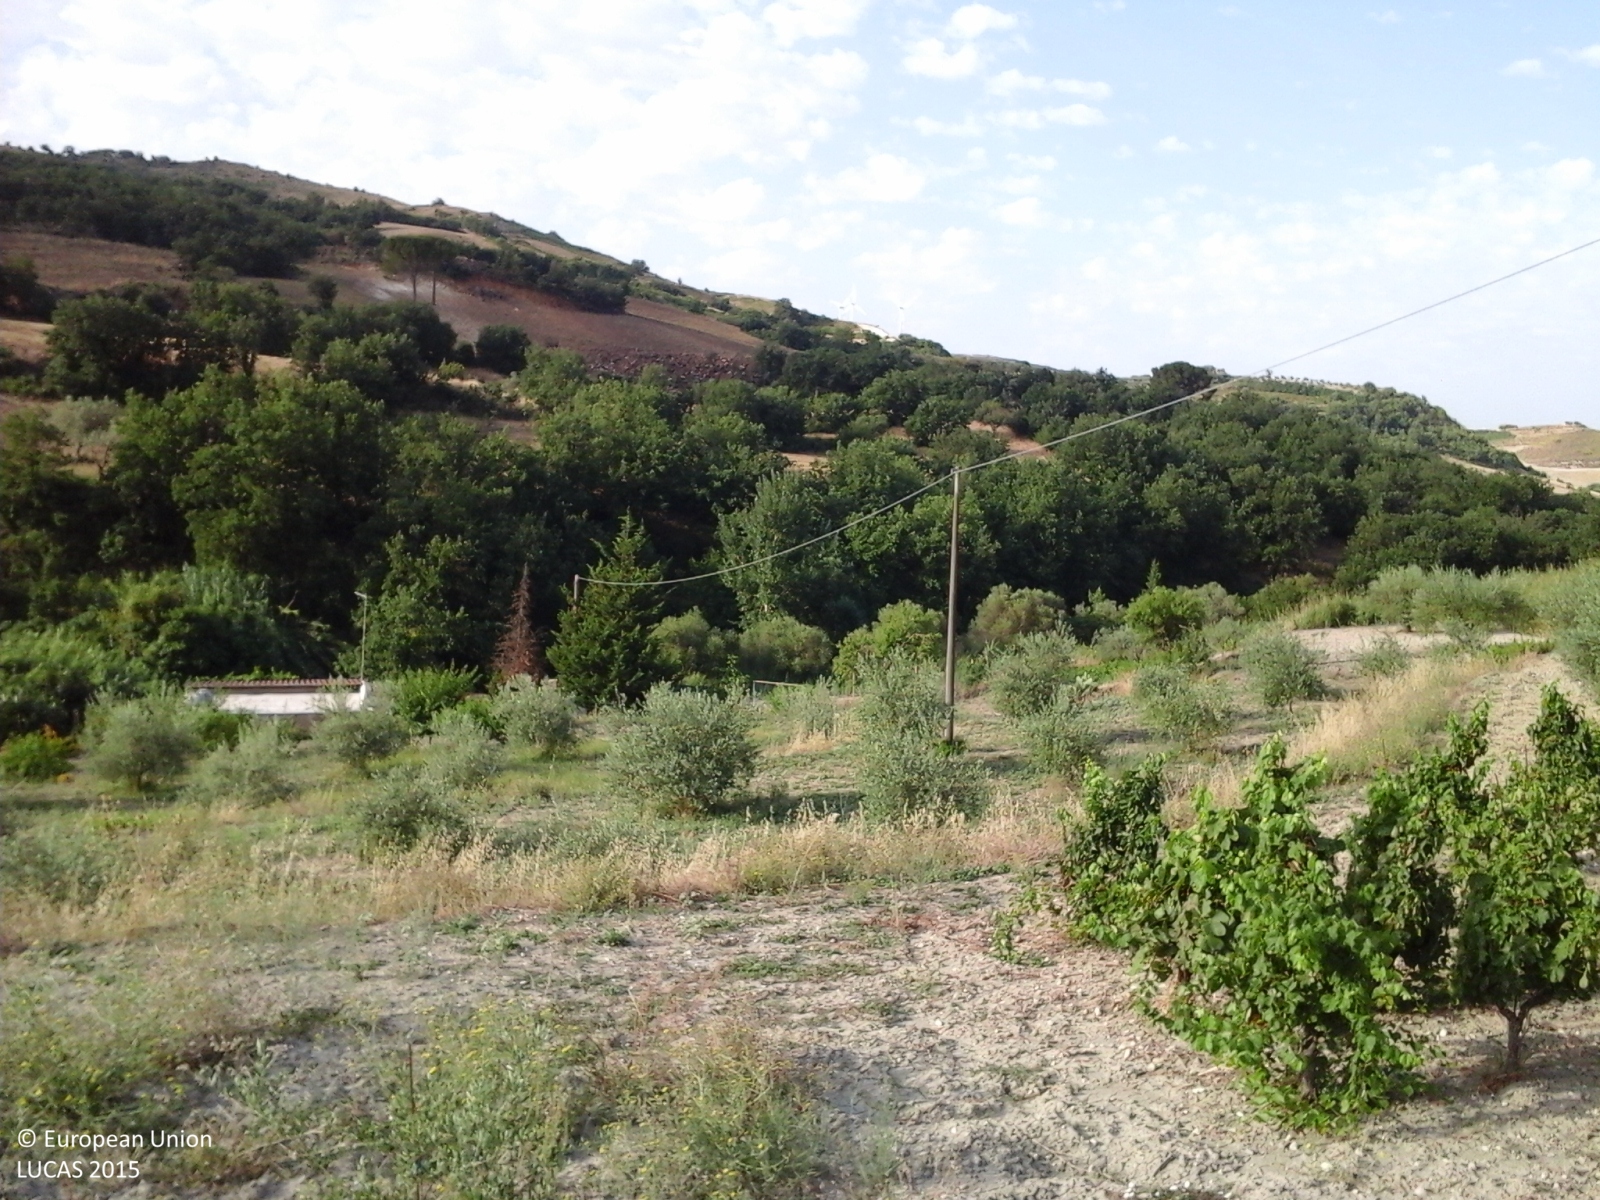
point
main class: Grassland
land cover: Spontaneously vegetated surfaces
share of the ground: 10 - 25 %
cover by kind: unconsolidated bare surface 75 %, herbaceous plants 25 %
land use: Agriculture (excluding fallow land and kitchen gardens)
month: August
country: IT
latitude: 37.1538
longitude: 14.7937
